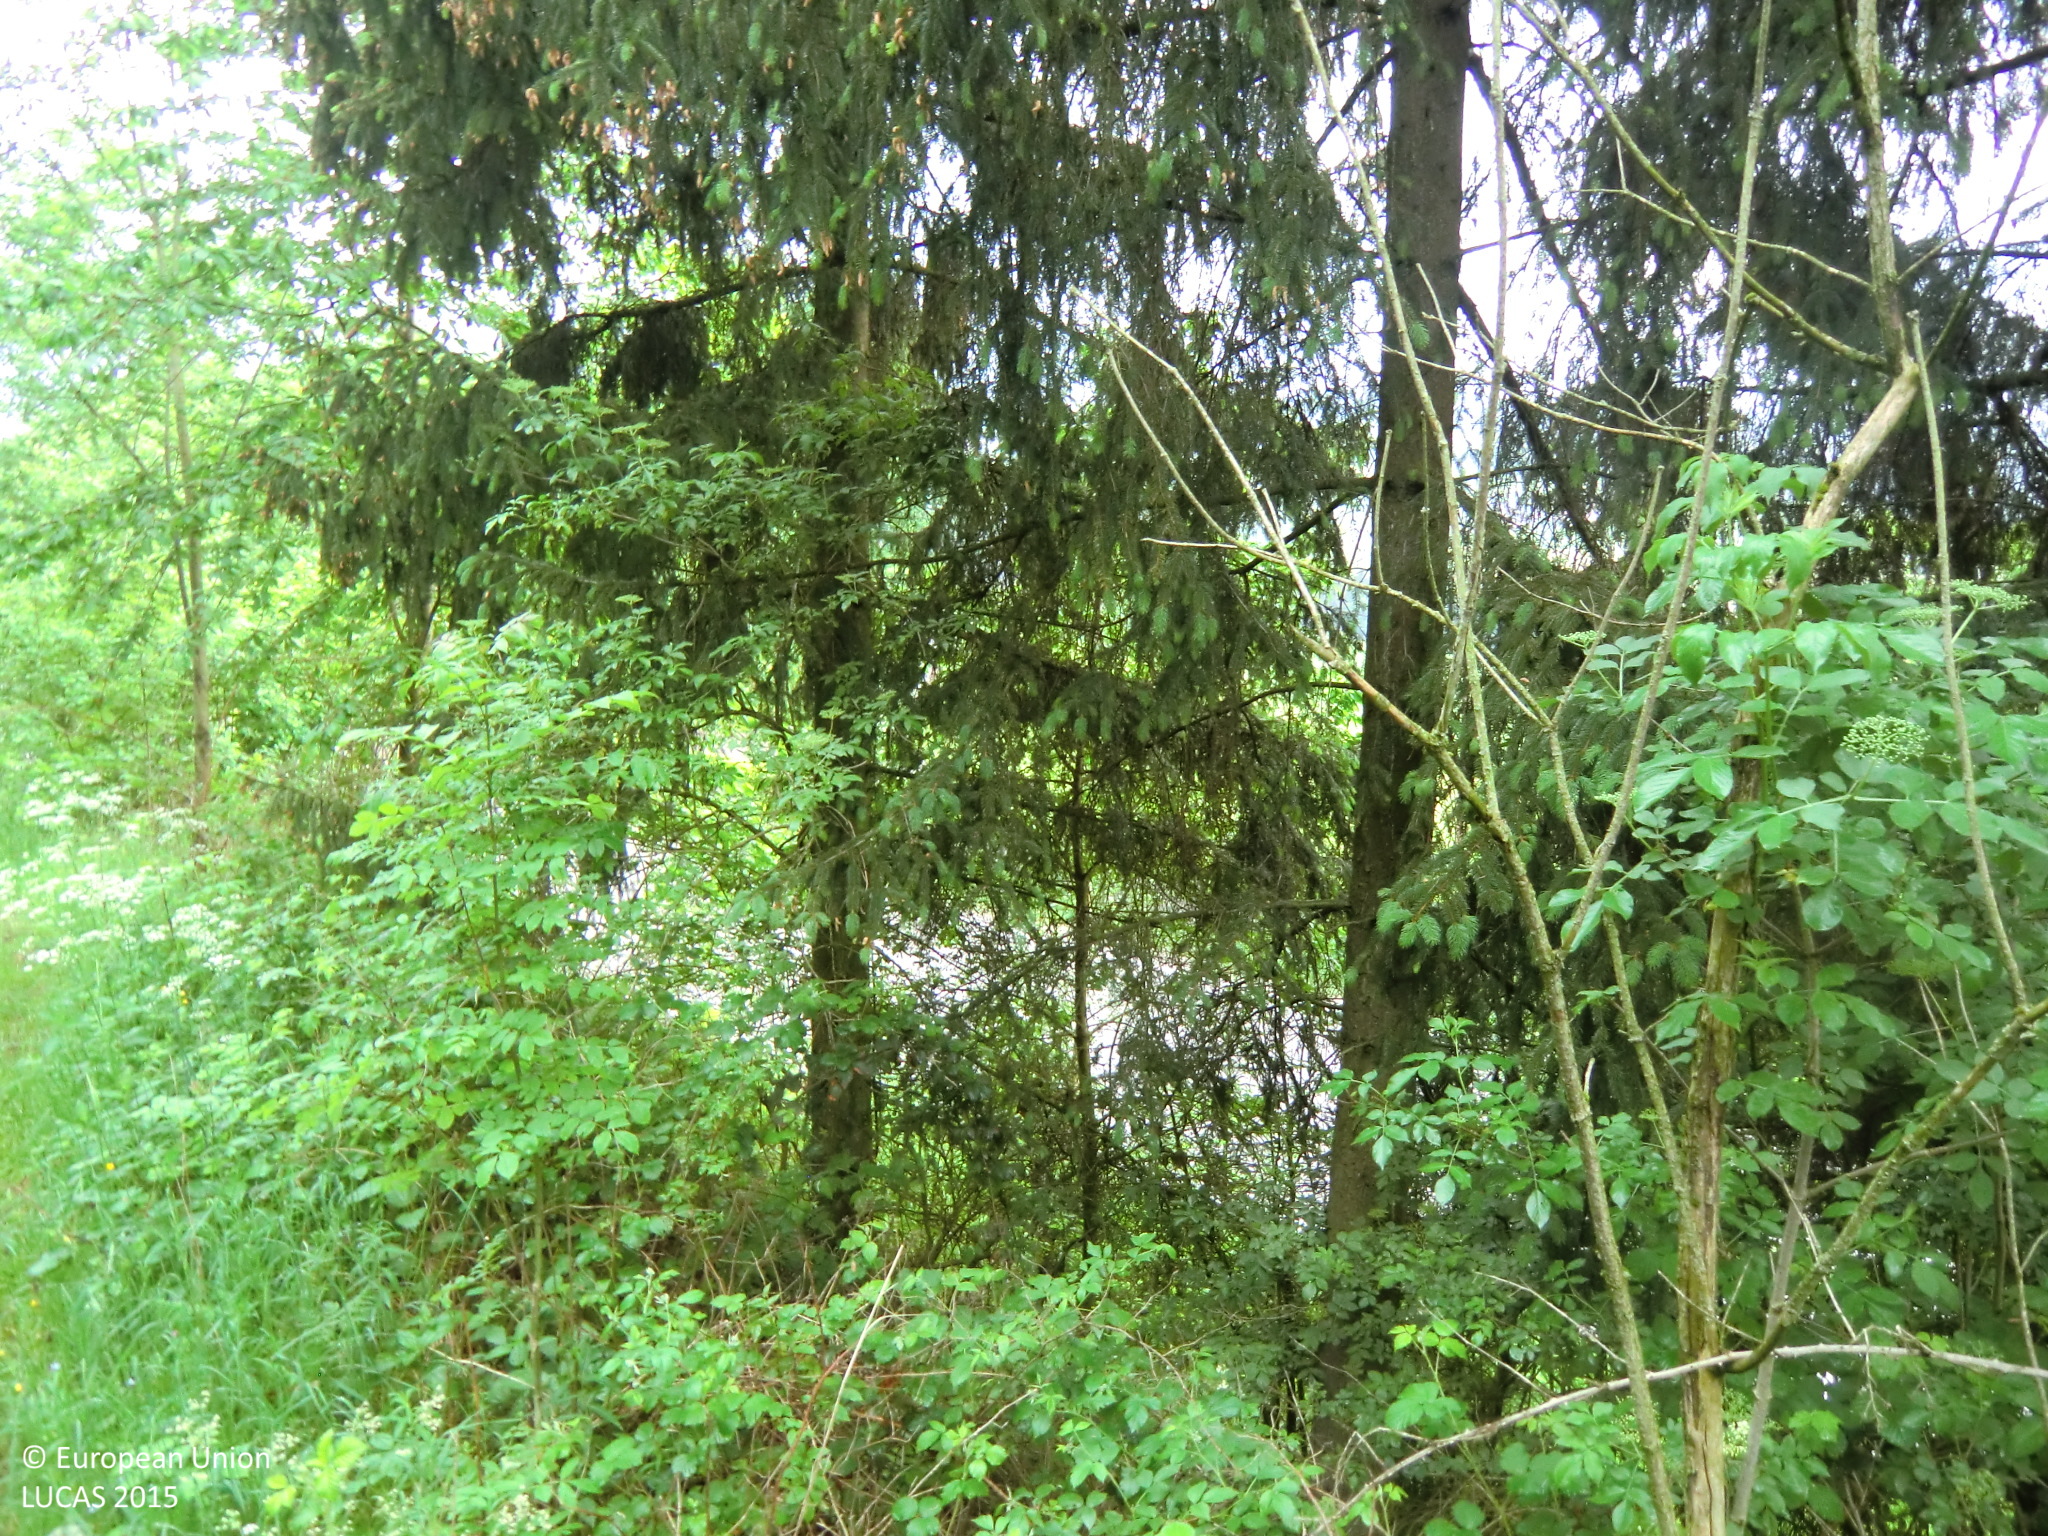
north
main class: Woodland
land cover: Spruce dominated mixed woodland
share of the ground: > 75 %
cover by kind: coniferous forest trees 60 %, broadleaved forest trees 20 %, shrubs 10 %, consolidated bare surface 10 %
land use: Forestry
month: May
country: AT
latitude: 48.3460
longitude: 14.5477
